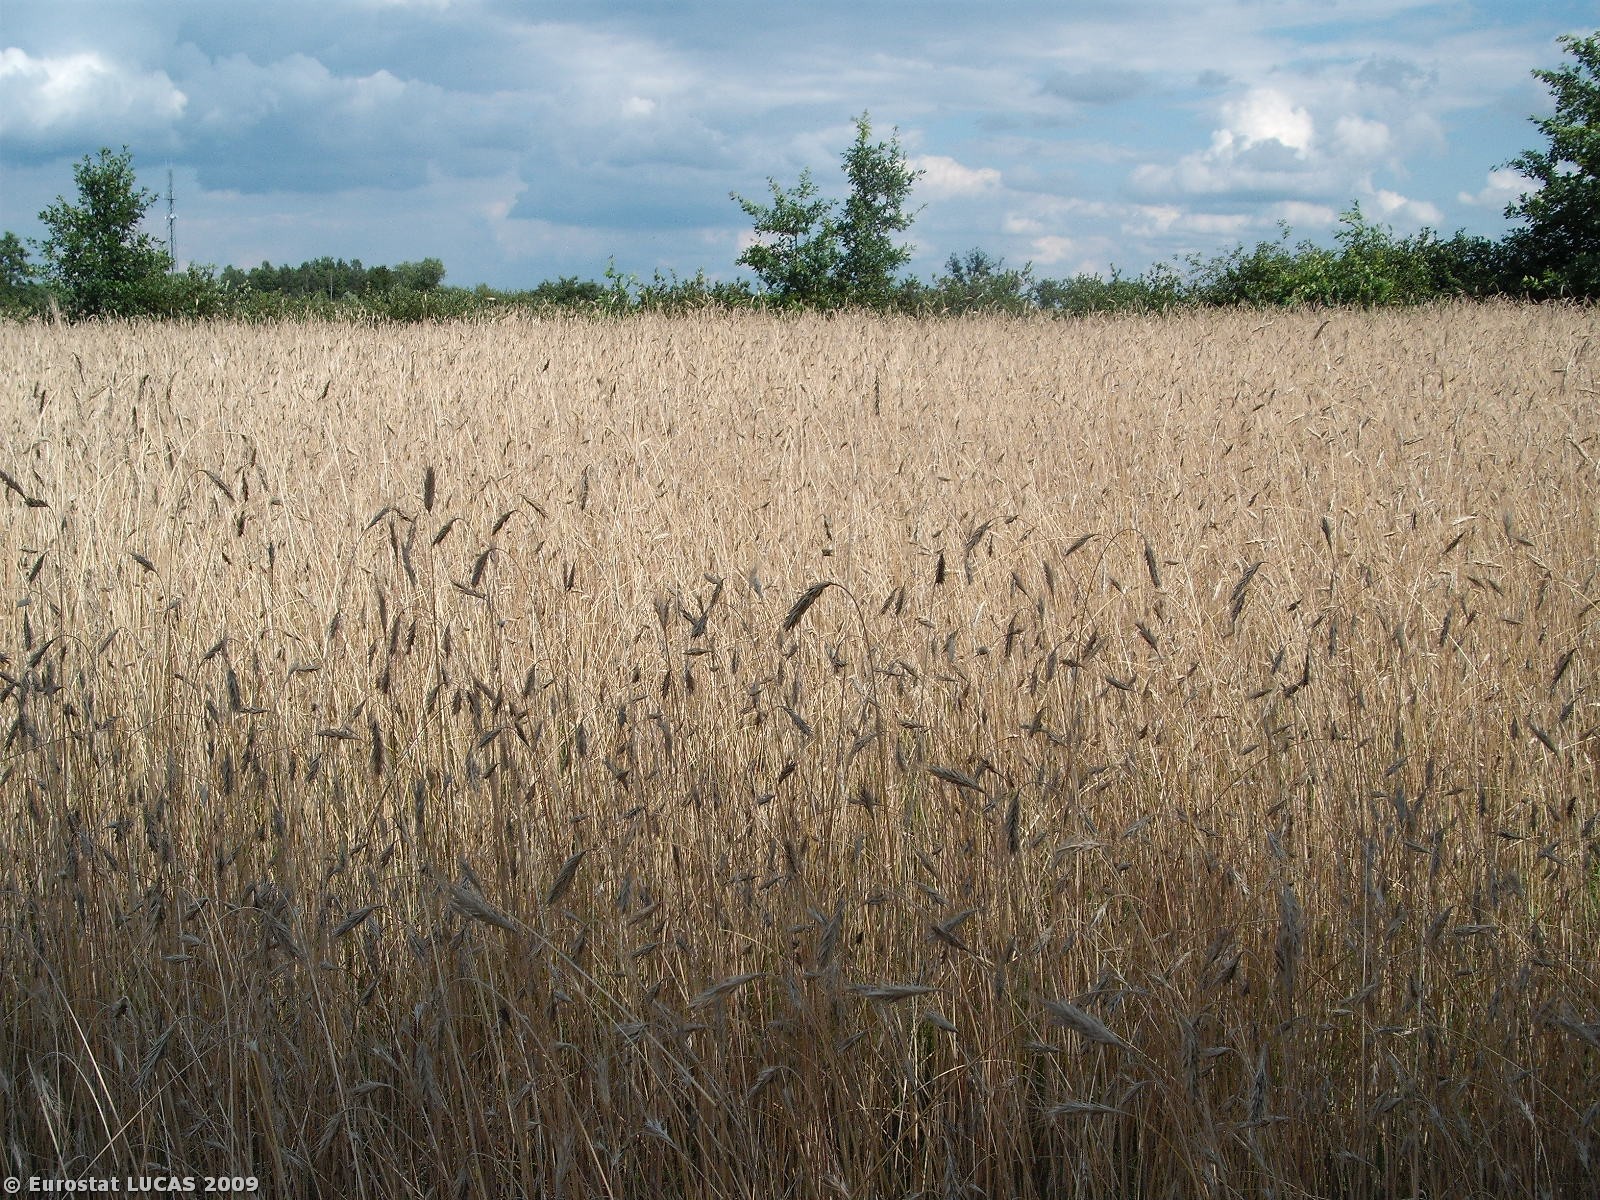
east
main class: Cropland
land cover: Rye
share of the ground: > 75 %
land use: Agriculture (excluding fallow land and kitchen gardens)
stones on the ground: < 10 %
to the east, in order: Rye; Grass margins; Abandoned hedges; Rye; Grass margins; Oats; Tracks; Oats; Grass margins; Triticale; Grass margins; Oats; Strawberries; Other fibre and oleaginous crops; Grass margins; Paved roads, cycling and walking lanes; Grass margins; Triticale; Lines of trees; Grassland without tree/shrub cover
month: July
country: PL
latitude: 51.3625
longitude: 21.4978
